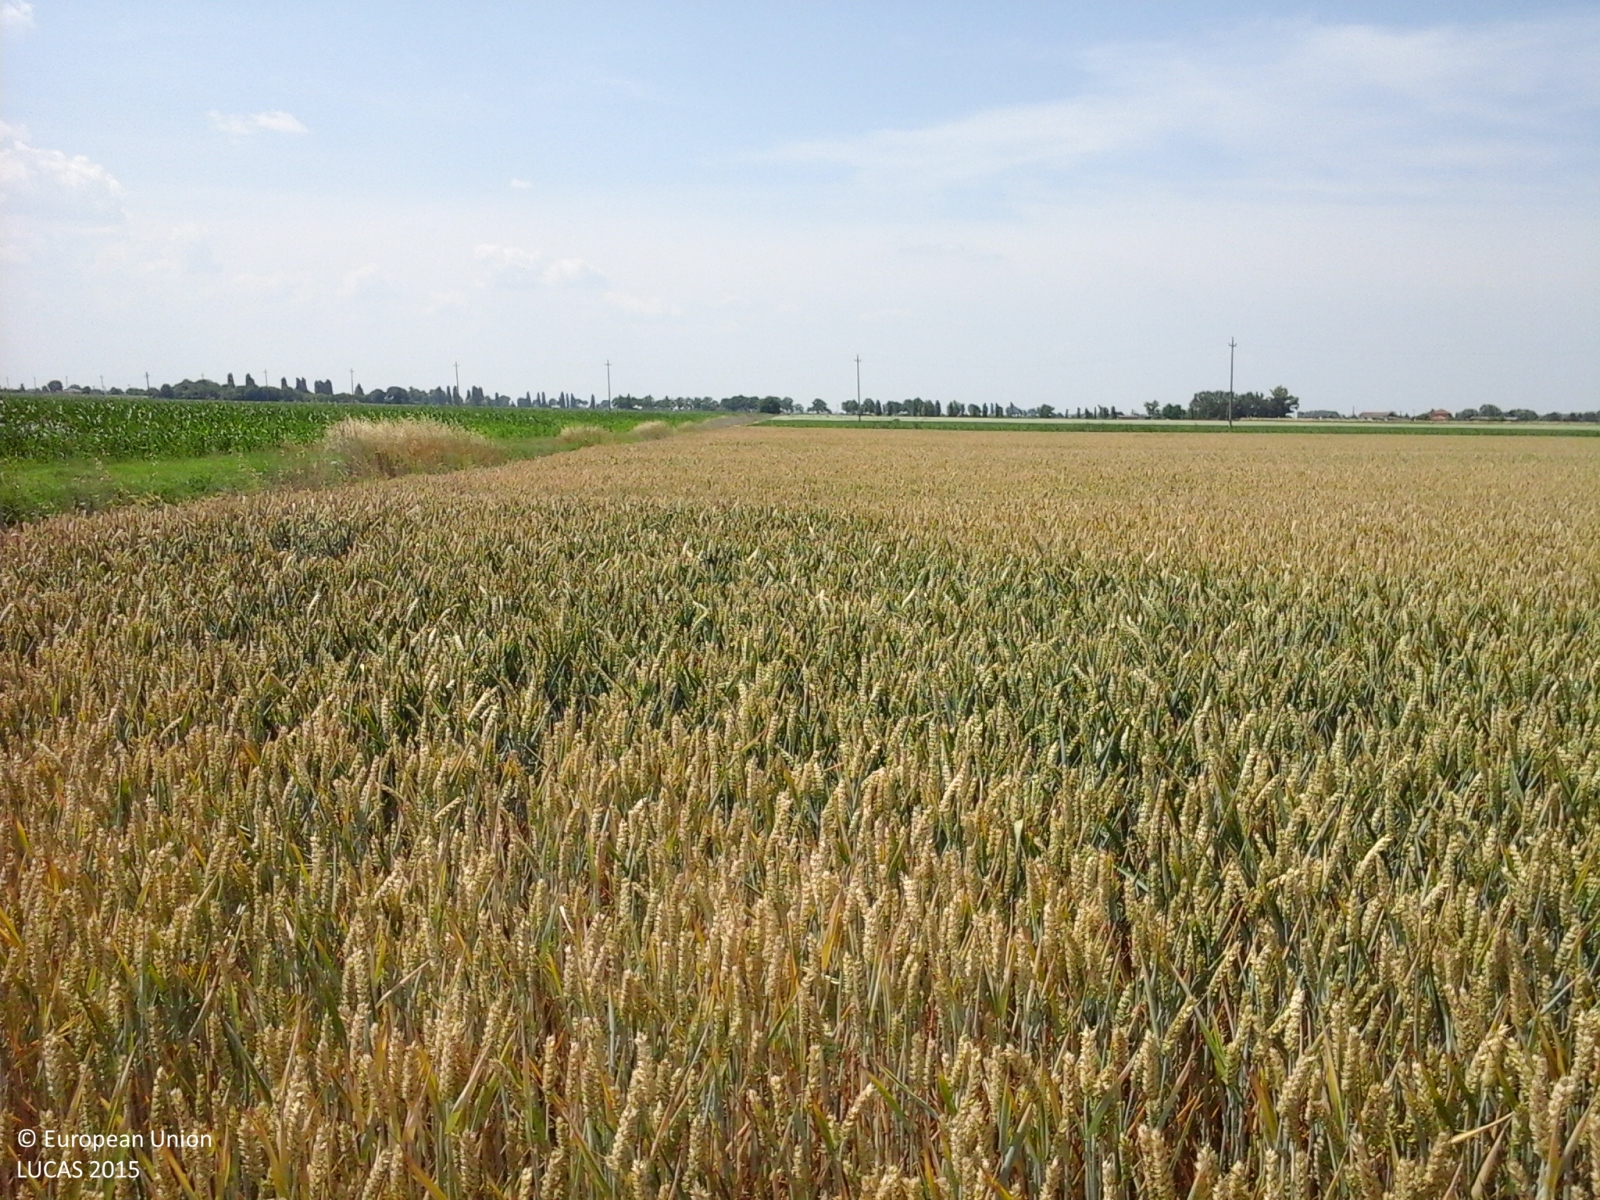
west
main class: Cropland
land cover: Common wheat
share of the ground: > 75 %
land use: Agriculture (excluding fallow land and kitchen gardens)
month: June
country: IT
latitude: 44.6759
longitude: 11.9010
